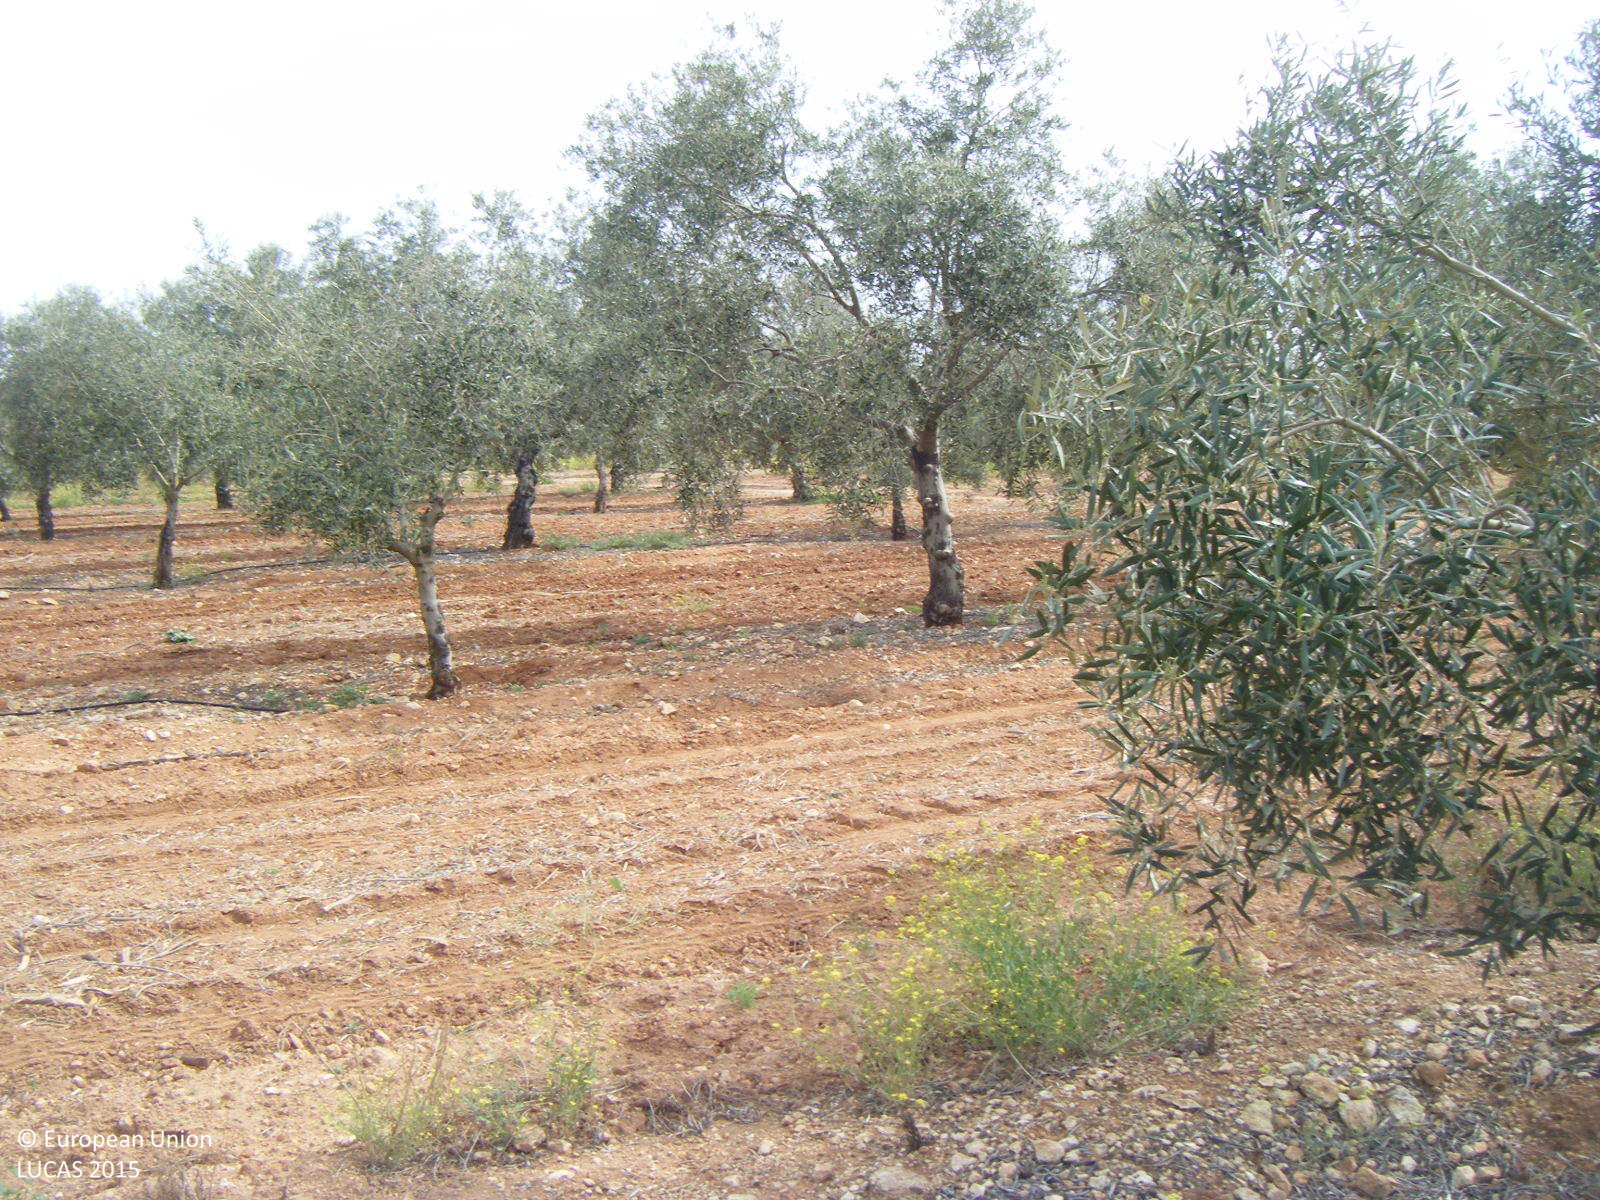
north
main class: Cropland
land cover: Olive groves
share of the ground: 10 - 25 %
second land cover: Other bare soil
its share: > 75 %
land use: Agriculture (excluding fallow land and kitchen gardens)
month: April
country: ES
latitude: 37.0696
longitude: -4.7450
